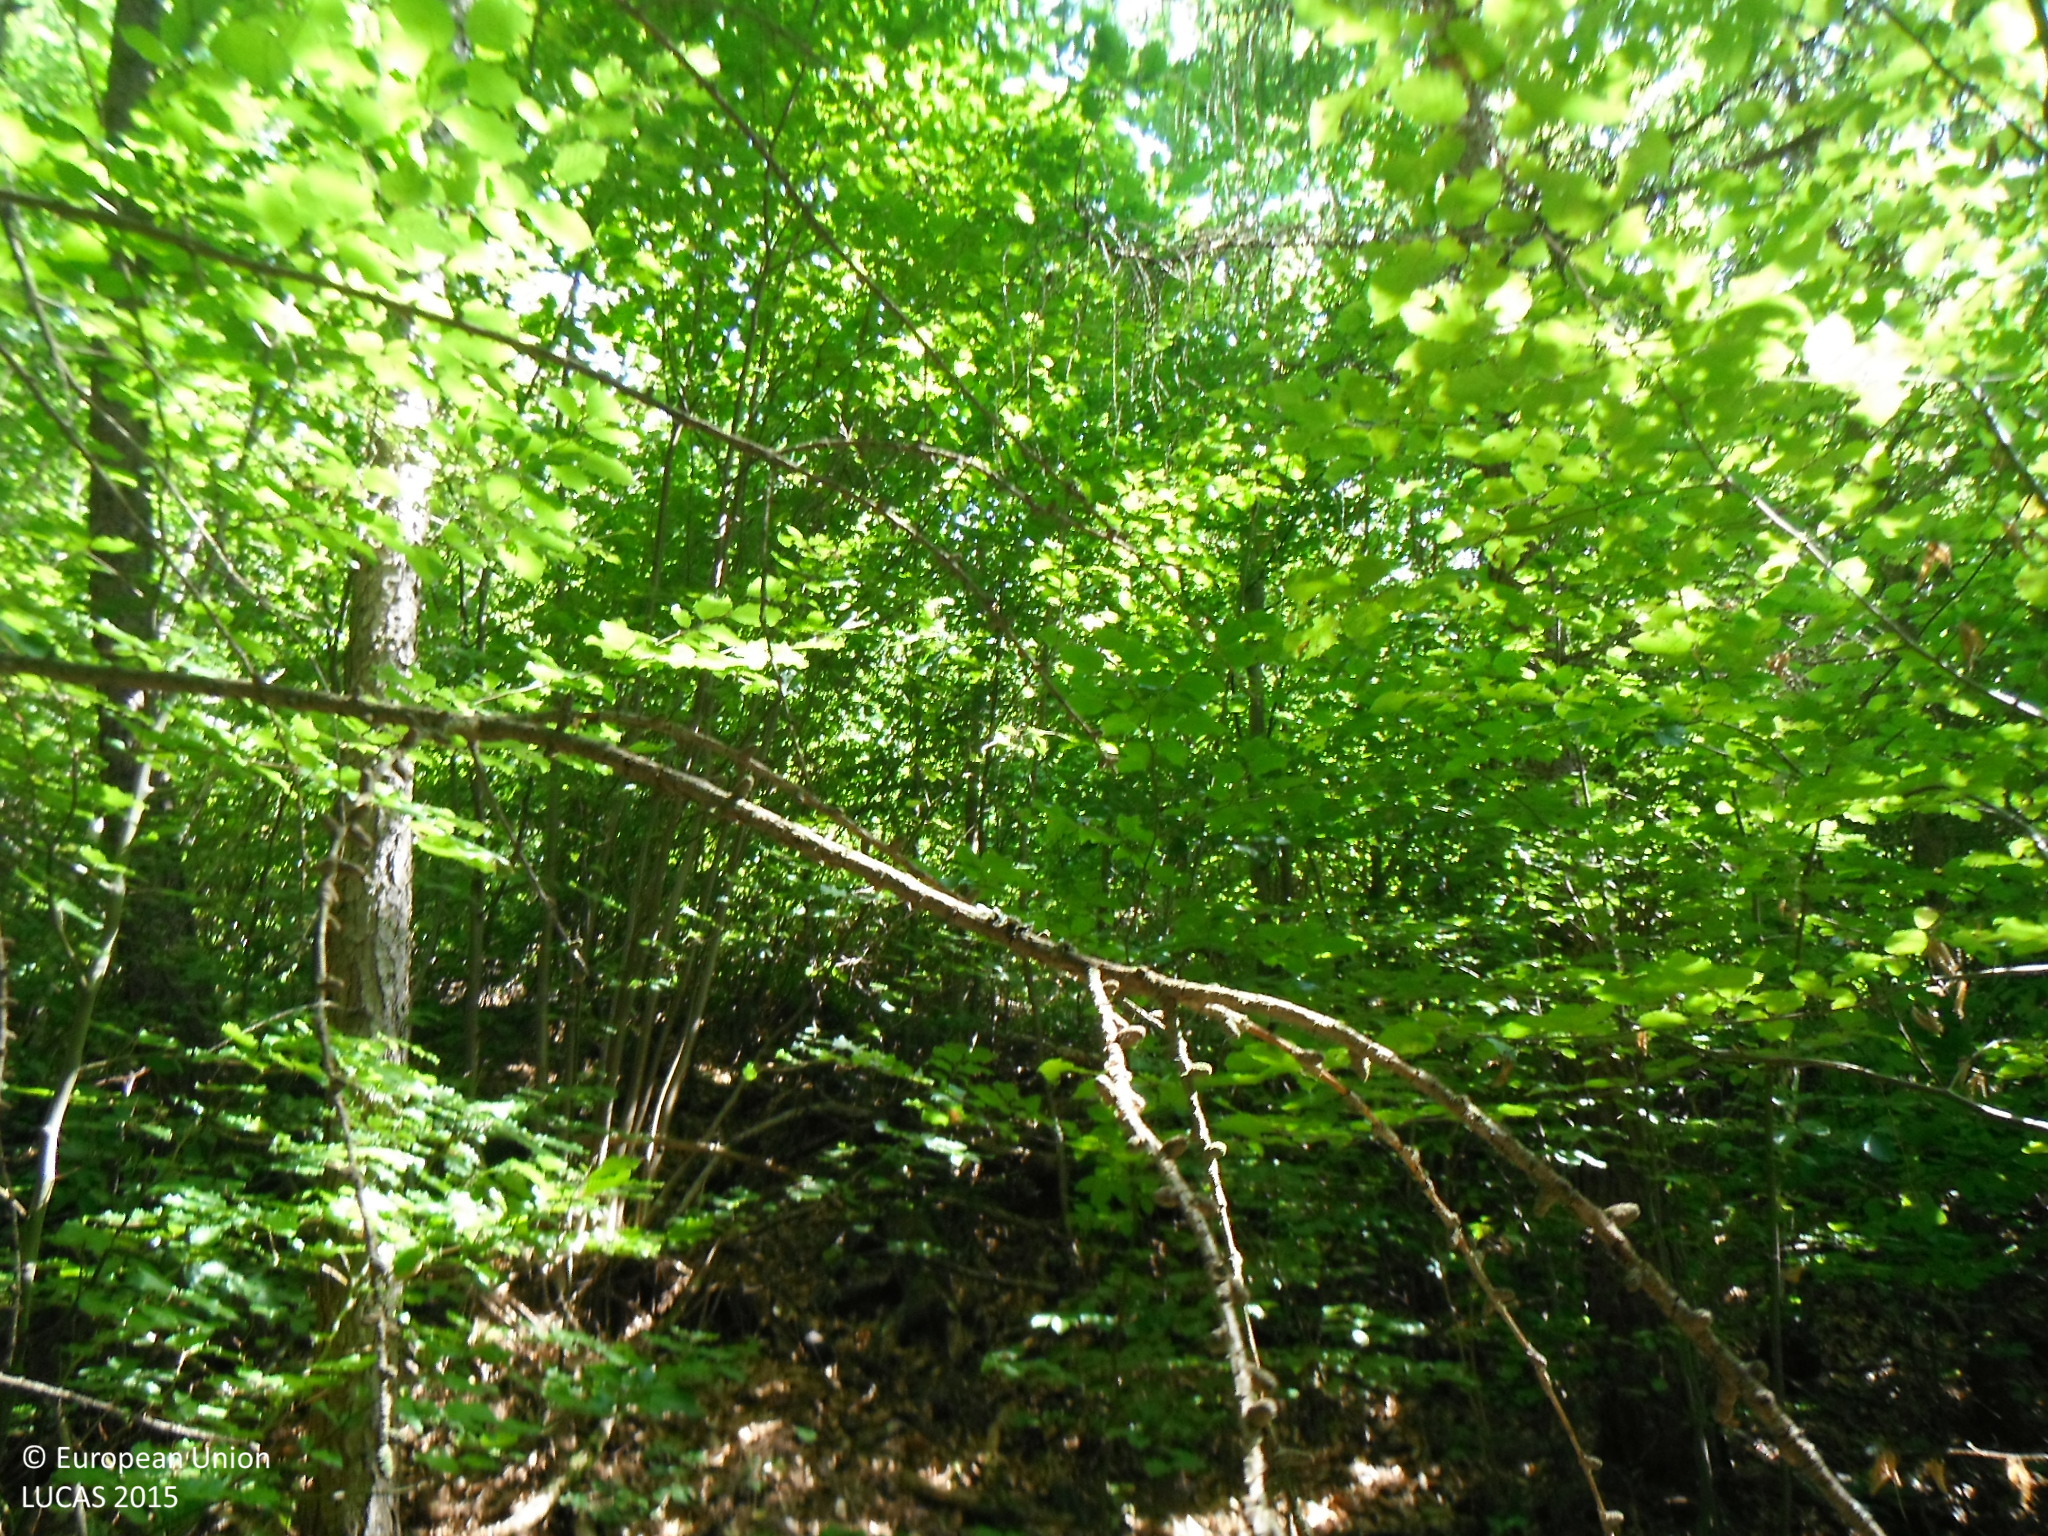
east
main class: Woodland
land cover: Other coniferous woodland
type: hemiboreal forest and nemoral coniferous forest and mixed broadleaved-coniferous forest
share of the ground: > 75 %
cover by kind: coniferous forest trees 90 %, broadleaved forest trees 10 %
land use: Forestry
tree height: > 5 m
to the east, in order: Other coniferous woodland; Shrubland with sparse tree cover; Broadleaved woodland; Tracks; Grassland without tree/shrub cover
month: August
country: SK
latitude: 49.0937
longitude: 18.1915
